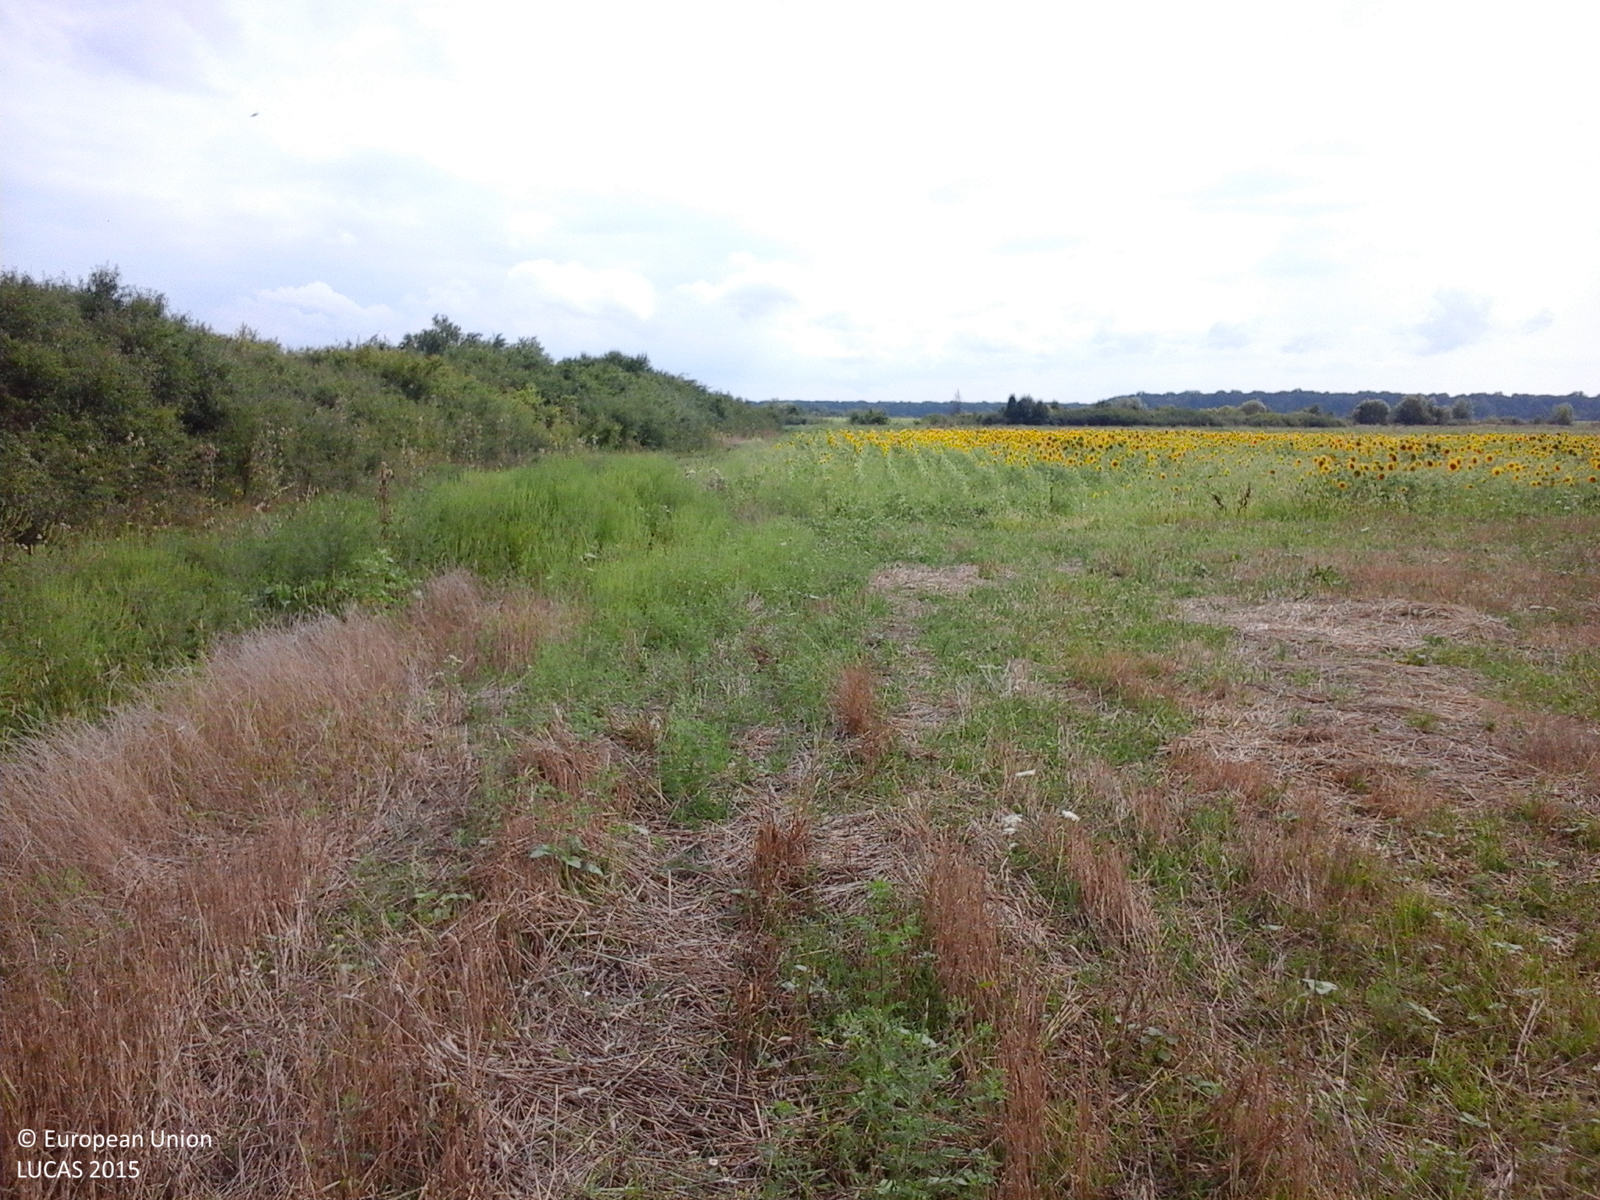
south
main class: Cropland
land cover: Common wheat
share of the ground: 10 - 25 %
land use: Agriculture (excluding fallow land and kitchen gardens)
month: August
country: RO
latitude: 45.7717
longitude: 21.4396
